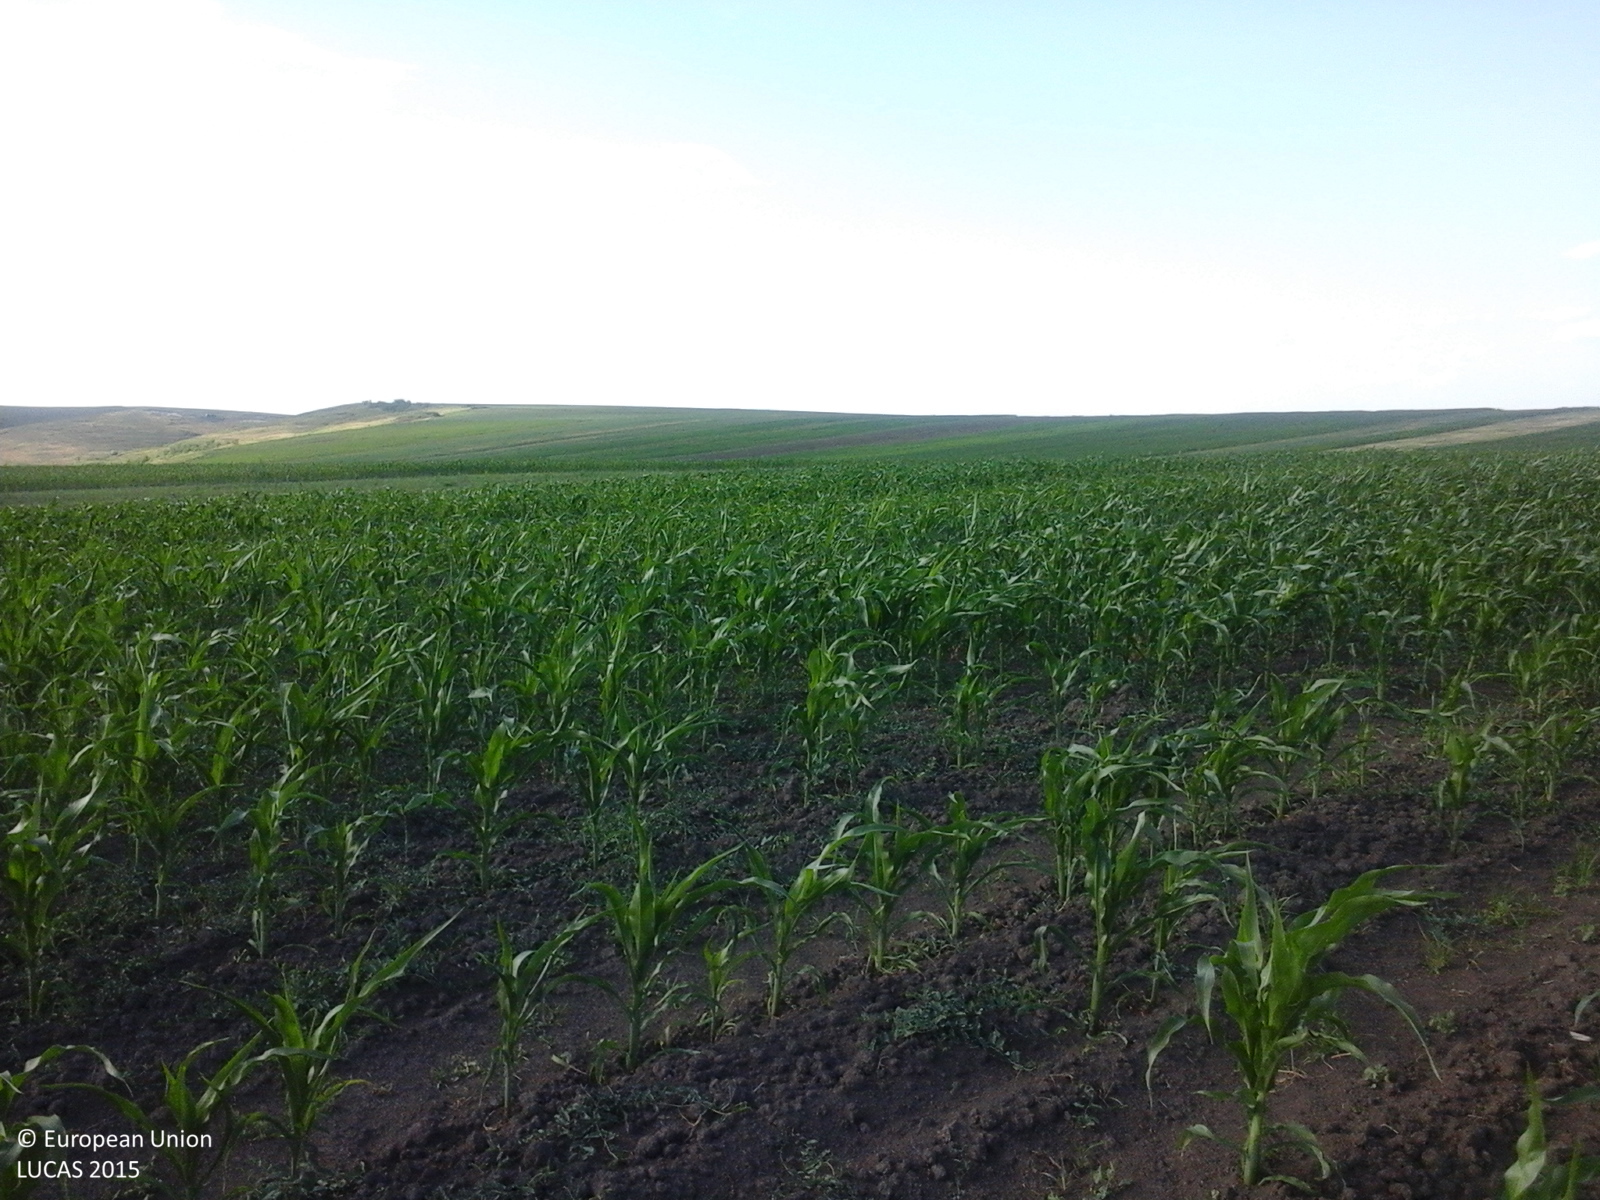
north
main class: Cropland
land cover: Maize
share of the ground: 25 - 50 %
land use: Agriculture (excluding fallow land and kitchen gardens)
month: June
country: RO
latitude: 47.7081
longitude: 26.8259
